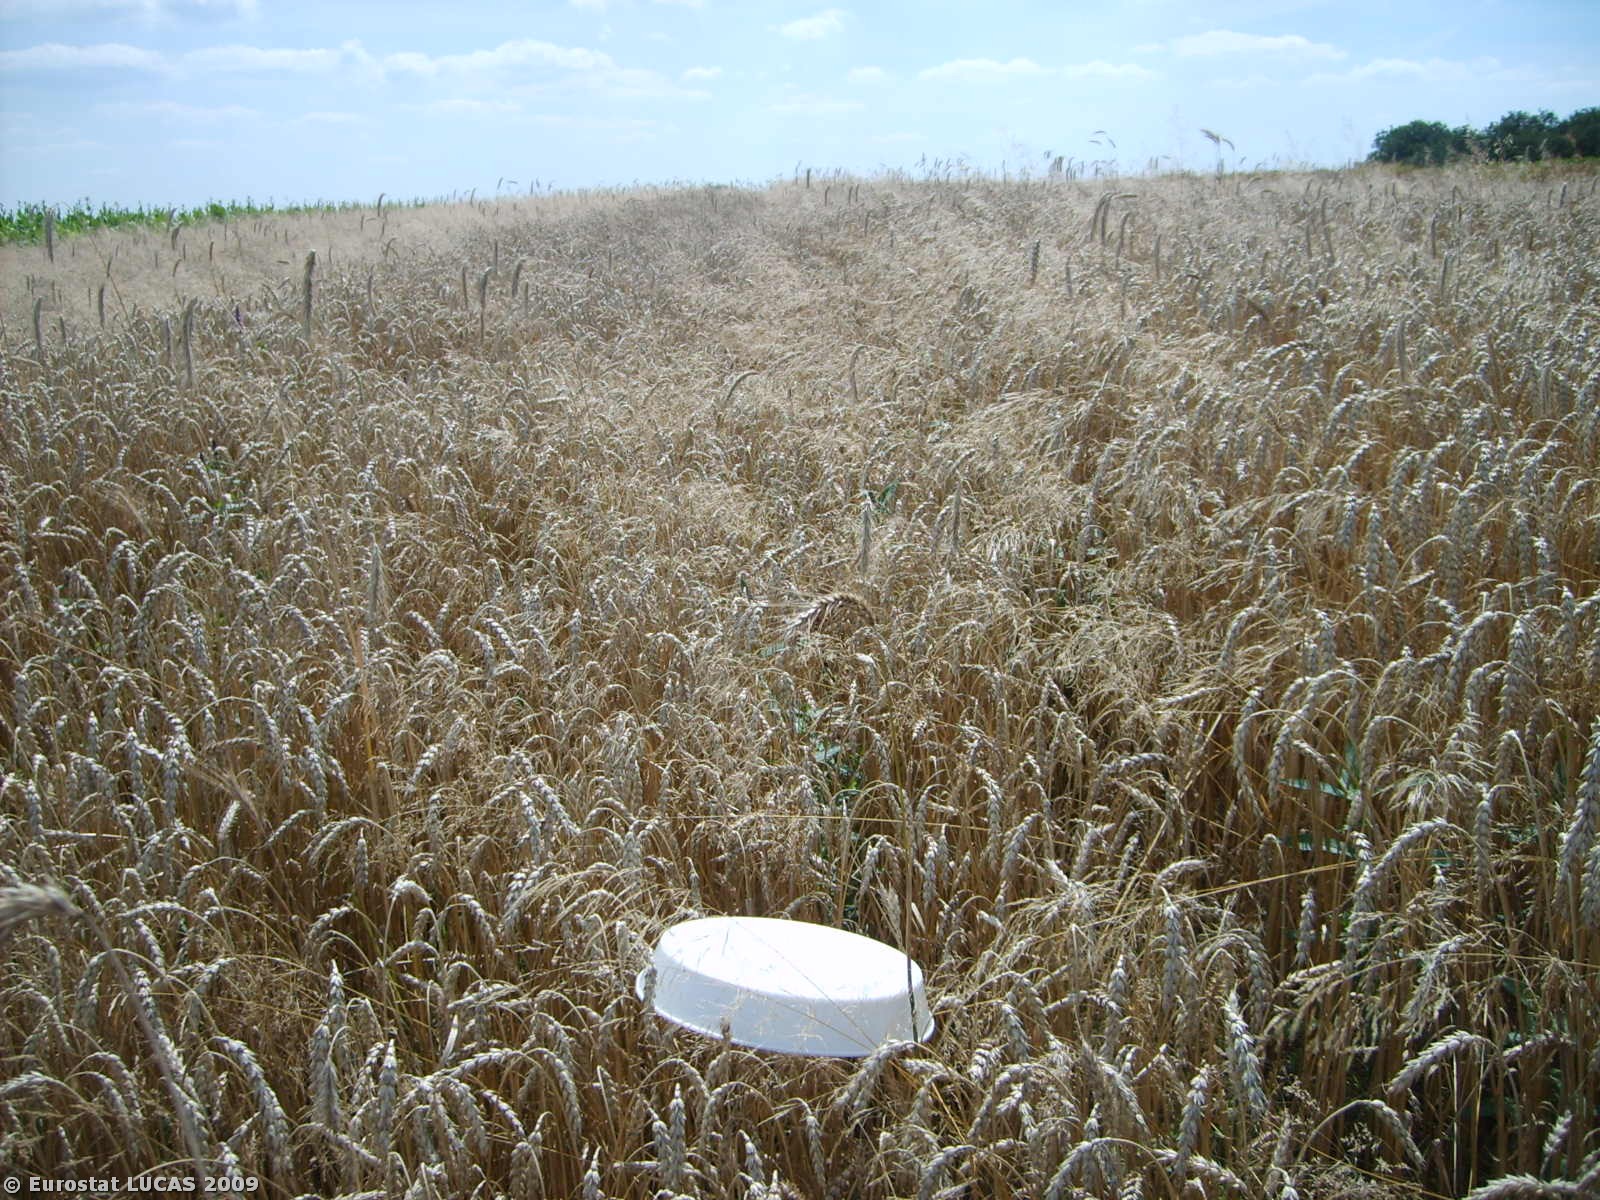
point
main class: Cropland
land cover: Common wheat
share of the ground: > 75 %
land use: Agriculture (excluding fallow land and kitchen gardens)
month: July
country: PL
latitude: 50.2182
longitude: 20.3652
